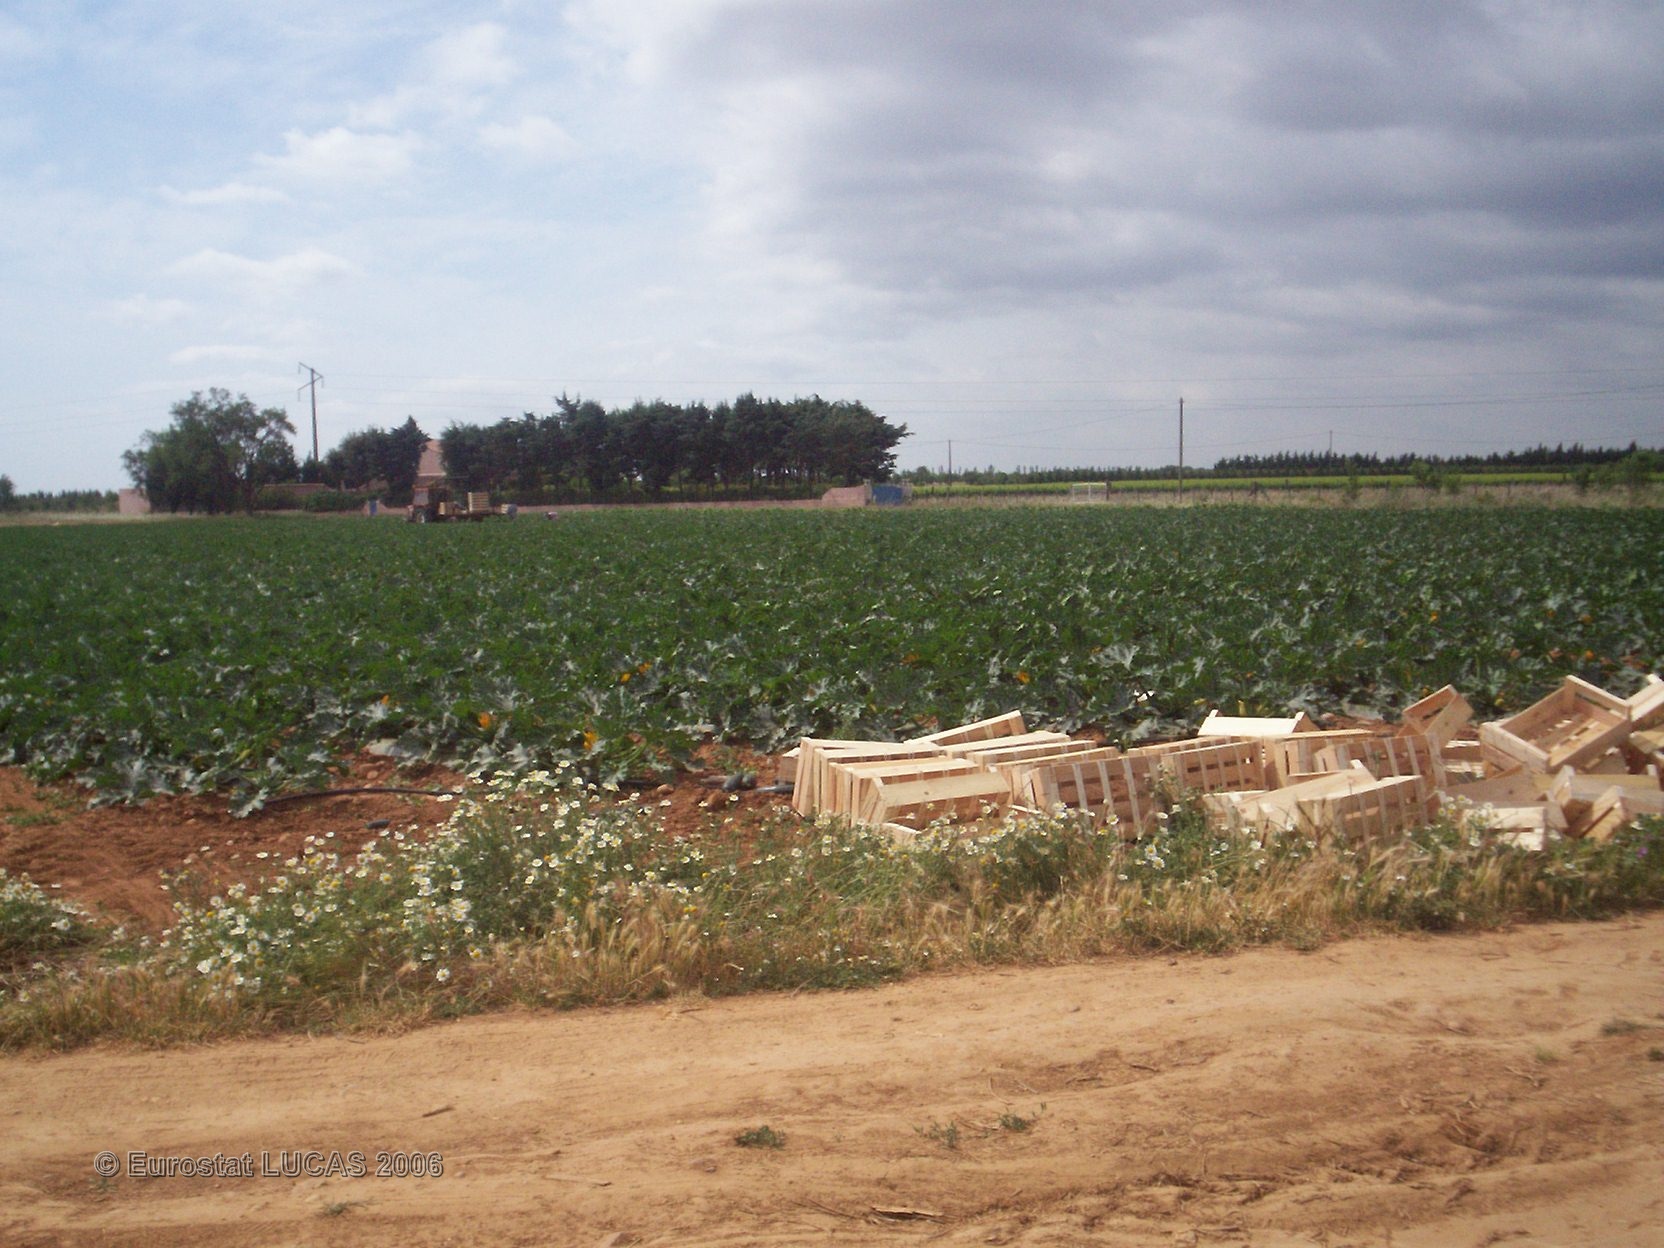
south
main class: Cropland
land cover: Other fresh vegetables
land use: Agriculture (excluding fallow land and kitchen gardens)
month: May
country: FR
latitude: 43.8058
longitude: 4.4774
